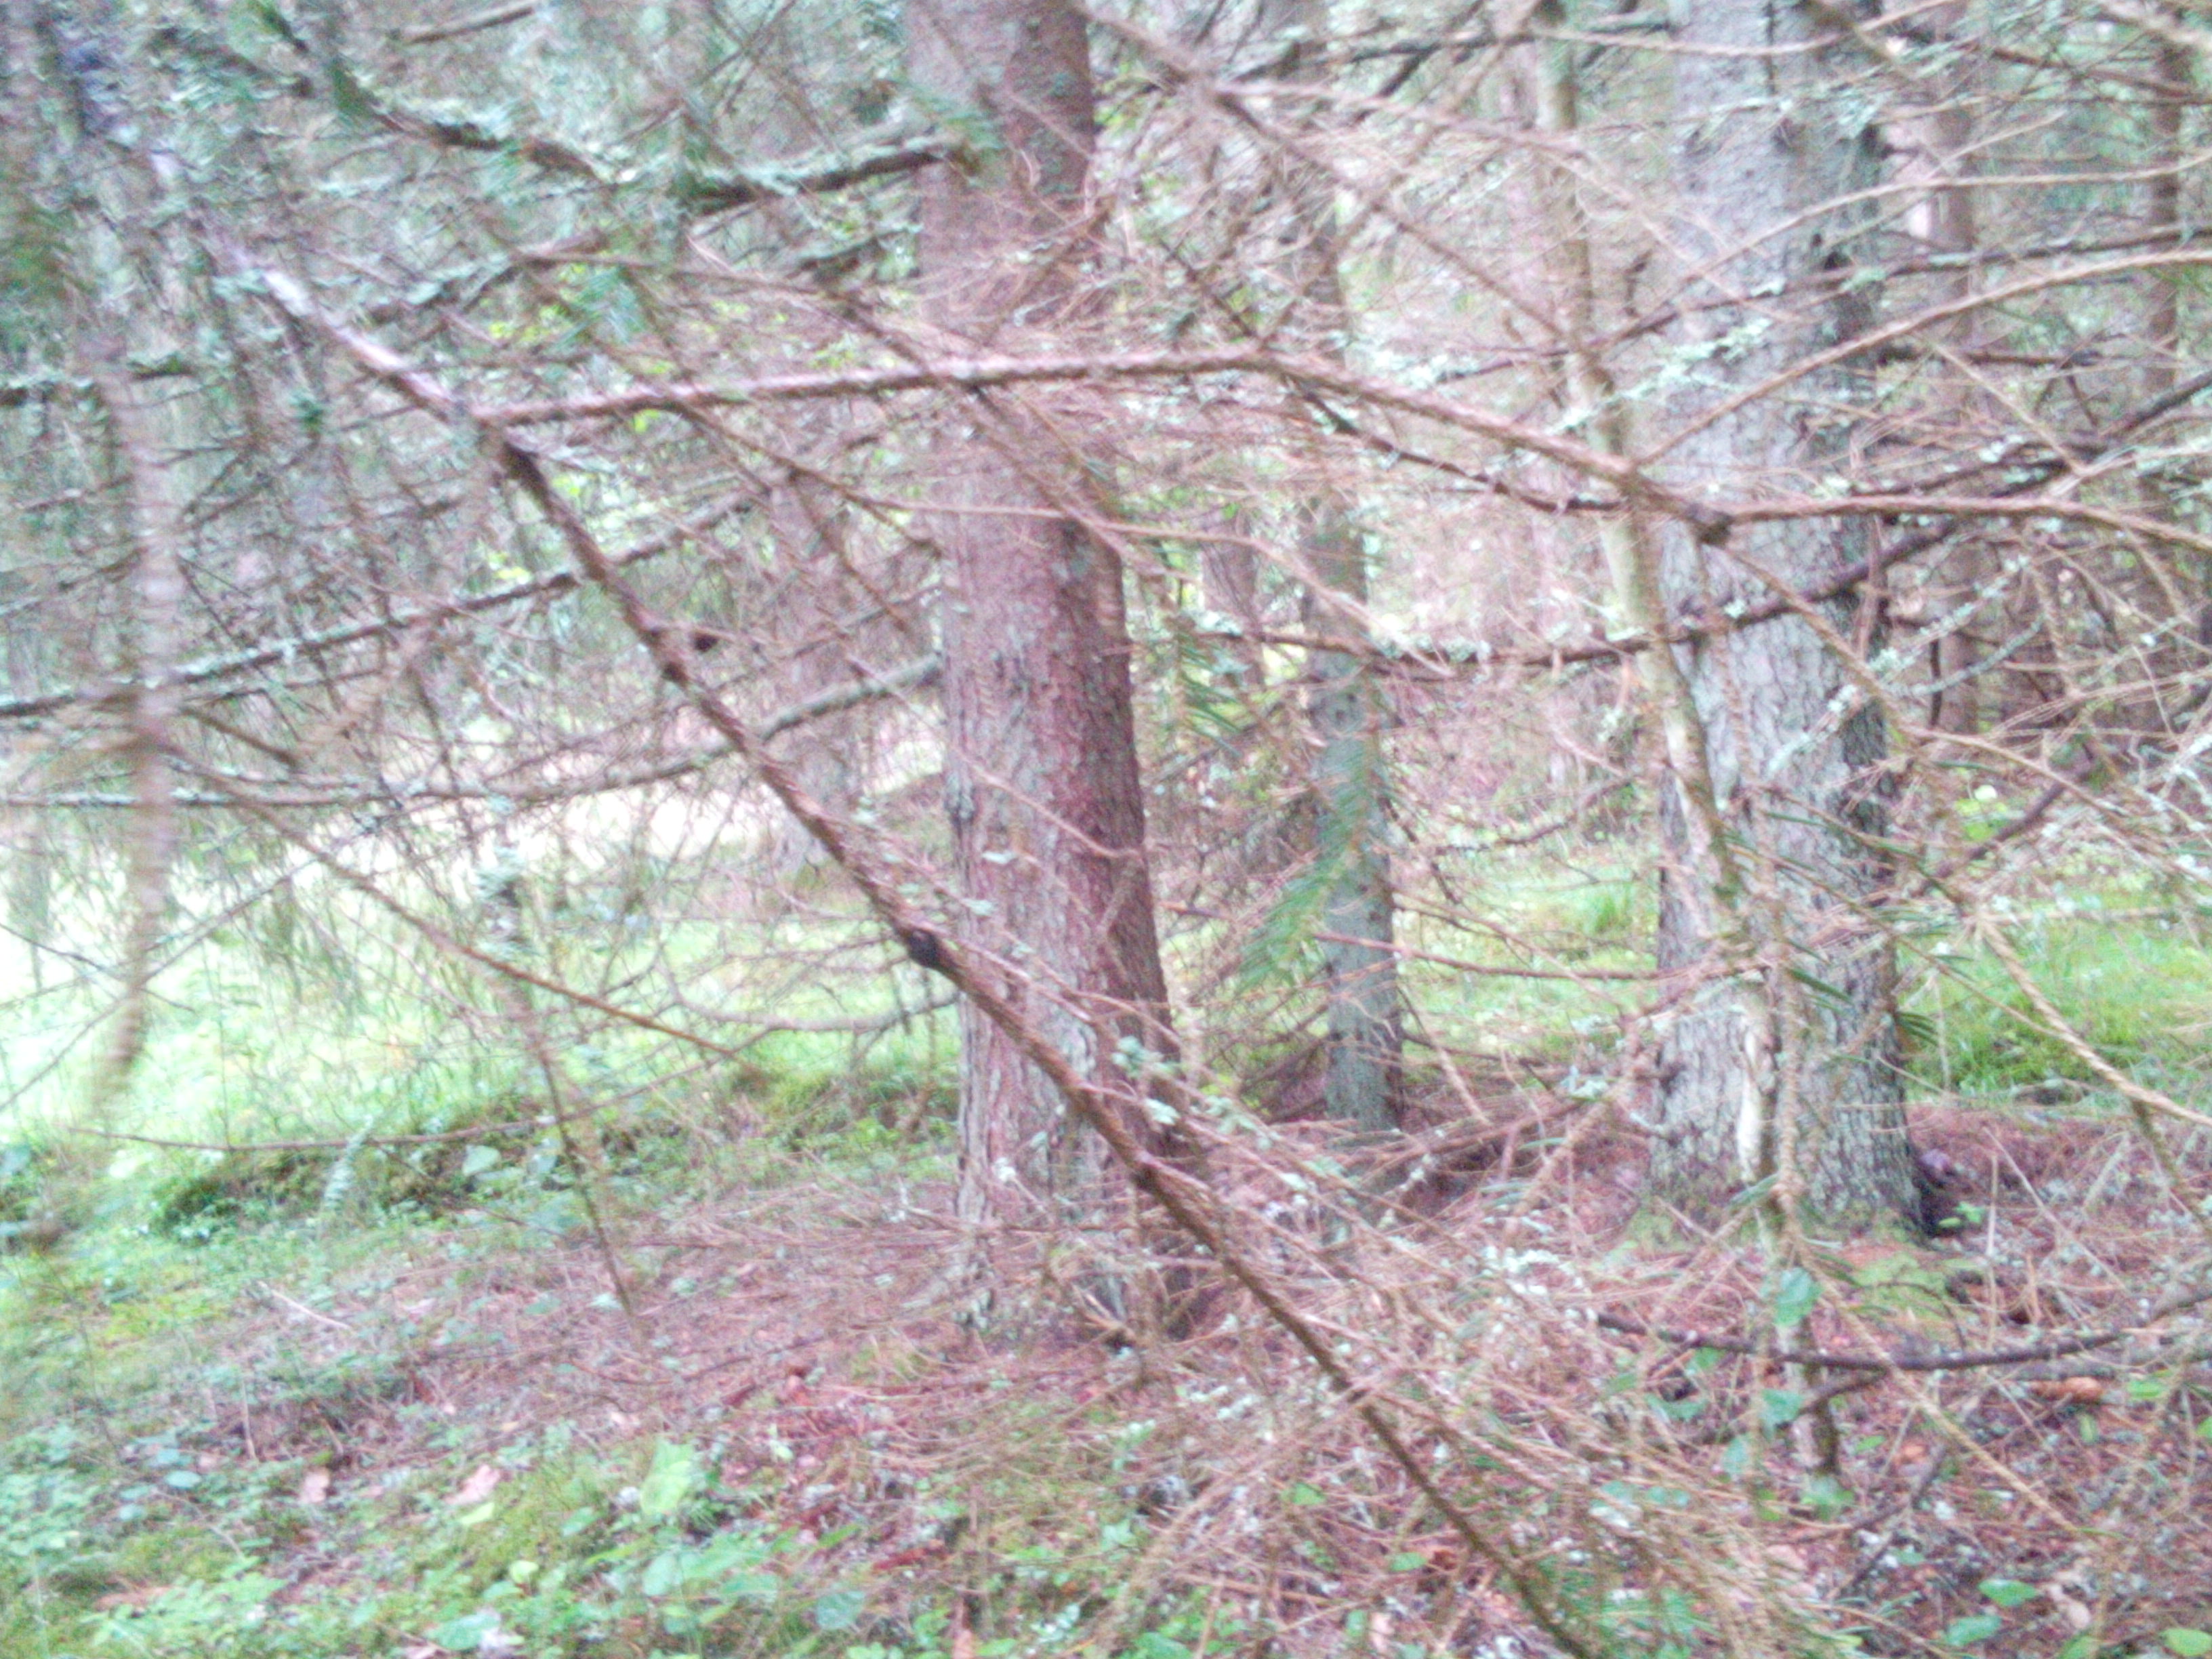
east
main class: Woodland
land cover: Spruce dominated coniferous woodland
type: hemiboreal forest and nemoral coniferous forest and mixed broadleaved-coniferous forest
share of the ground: > 75 %
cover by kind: coniferous forest trees 75 %, herbaceous plants 10 %, lichens and mosses 10 %, broadleaved forest trees 5 %
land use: Forestry
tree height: > 5 m
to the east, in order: Spruce dominated coniferous woodland; Pine dominated coniferous woodland; Ditches and canals; Other mixed woodland; Broadleaved woodland; Ditches and canals; Spontaneously vegetated surfaces
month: July
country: LV
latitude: 57.0101
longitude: 21.9523
